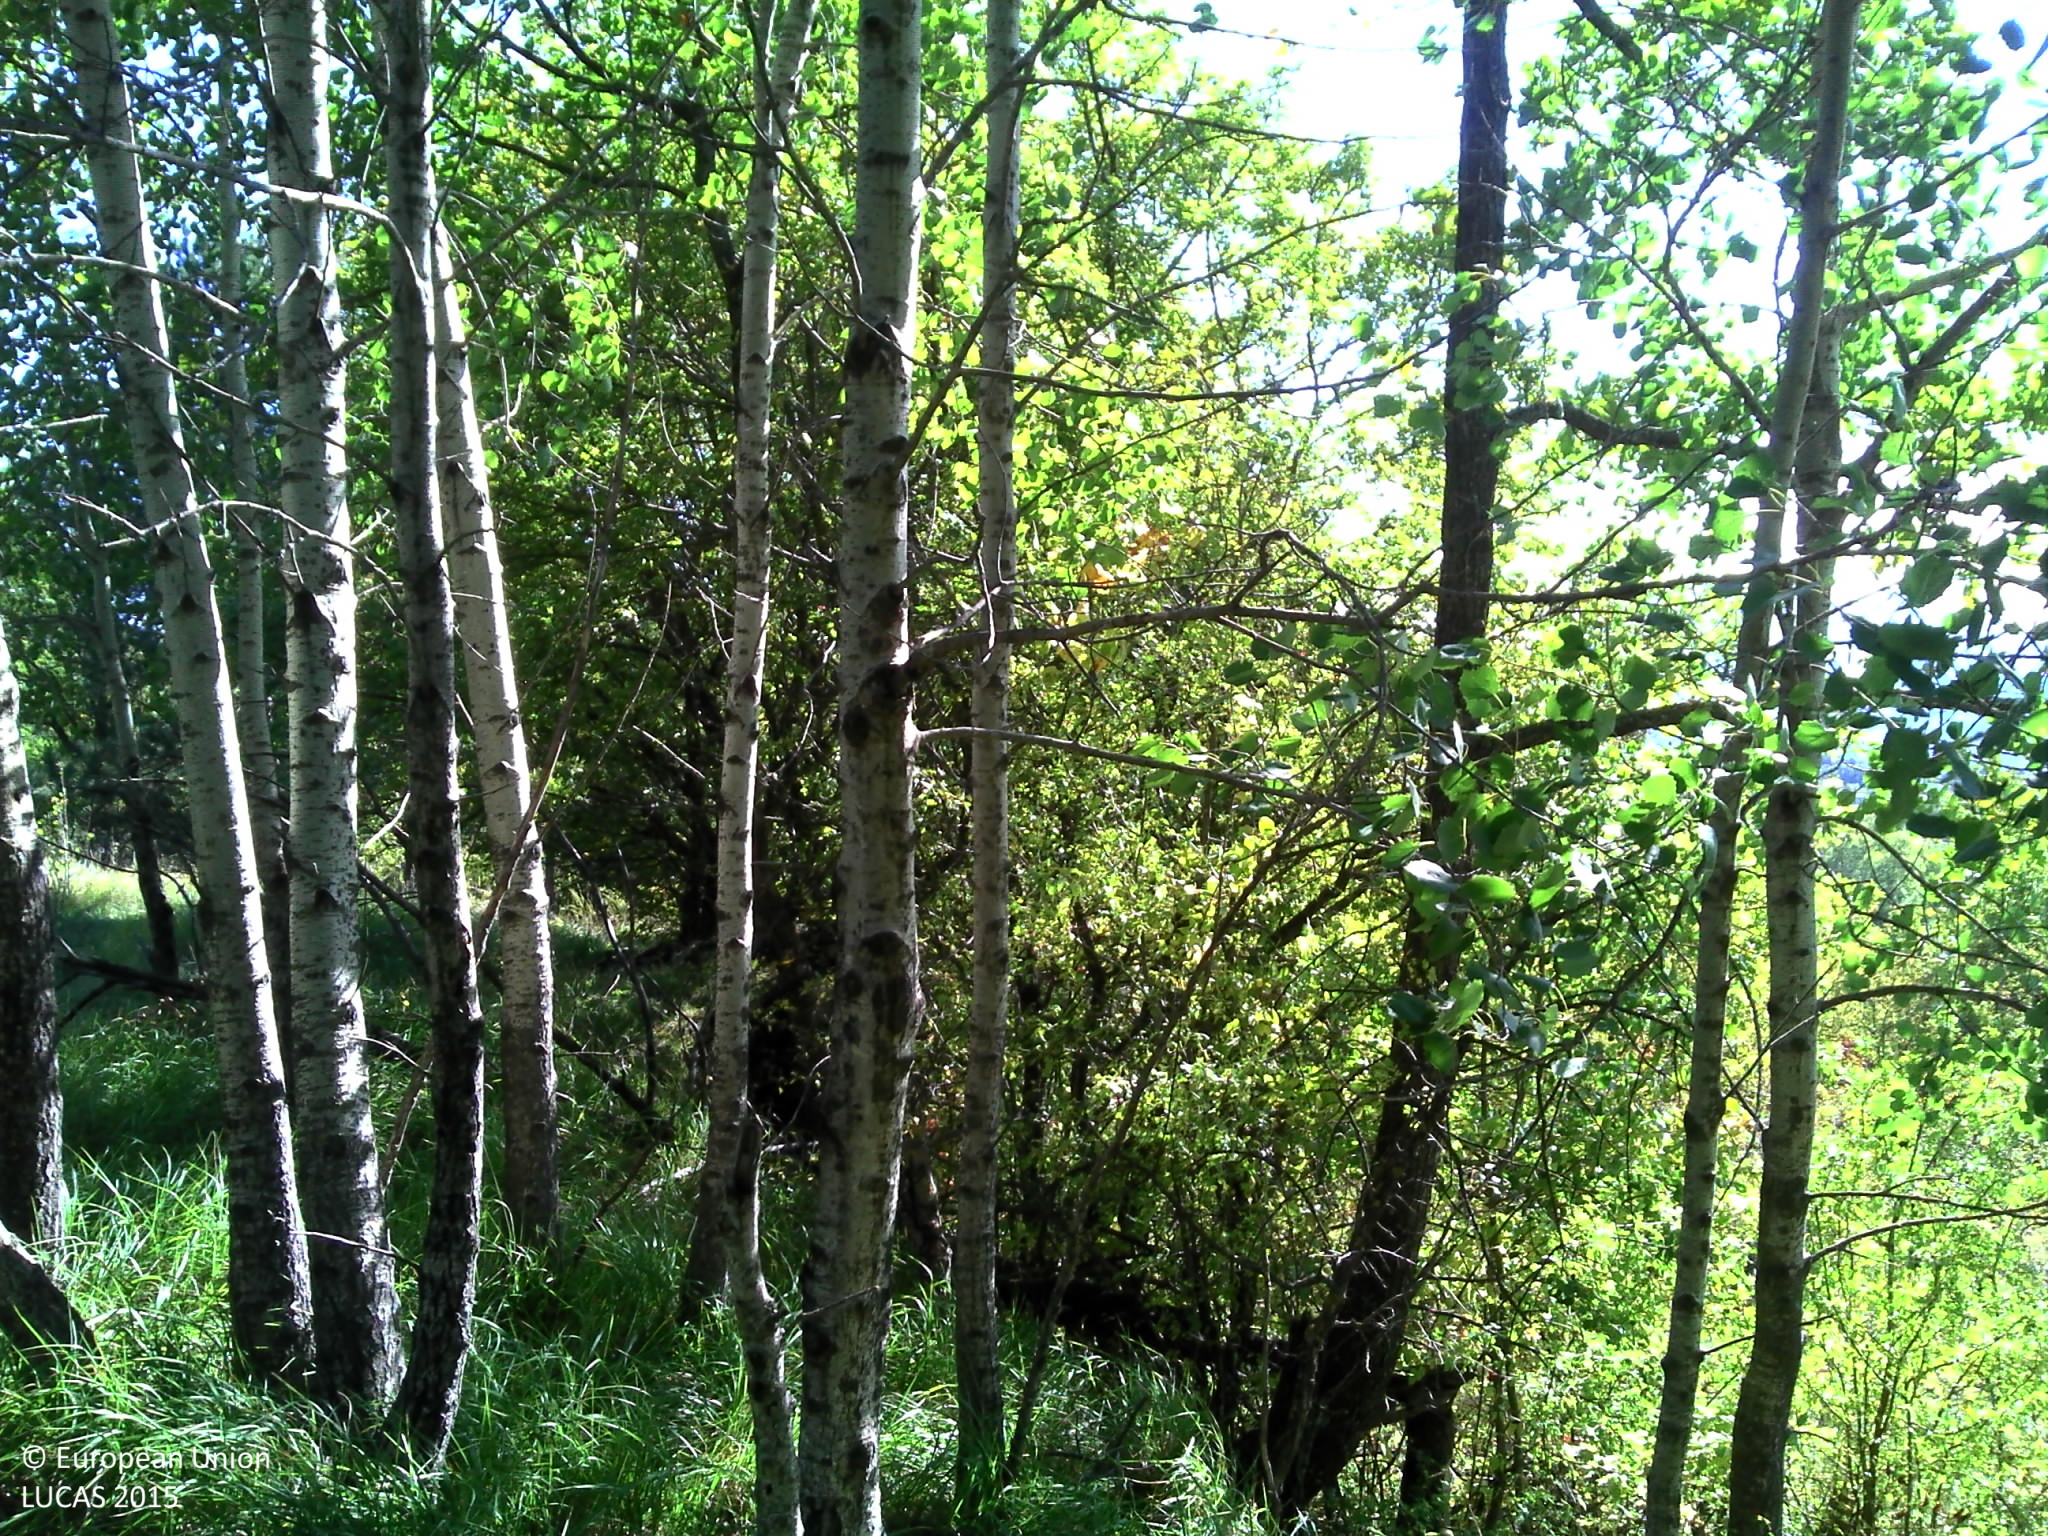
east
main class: Woodland
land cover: Broadleaved woodland
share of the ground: 25 - 50 %
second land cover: Grassland without tree/shrub cover
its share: > 75 %
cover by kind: broadleaved forest trees 70 %, herbaceous plants 25 %, coniferous forest trees 5 %
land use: Forestry
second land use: Agriculture (excluding fallow land and kitchen gardens)
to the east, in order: Broadleaved woodland; Grassland without tree/shrub cover; Tracks; Grassland without tree/shrub cover; Broadleaved woodland; Tracks; Broadleaved woodland; Grassland without tree/shrub cover; Tracks; Dry stone walls; Managed hedges; Grassland with sparse tree/shrub cover; Dry stone walls; Shrubland with sparse tree cover; Lines of trees; Artificial constructions; Shrubland with sparse tree cover; Tracks; Shrubland with sparse tree cover; Broadleaved woodland
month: October
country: FR
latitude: 44.5542
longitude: 6.2677
